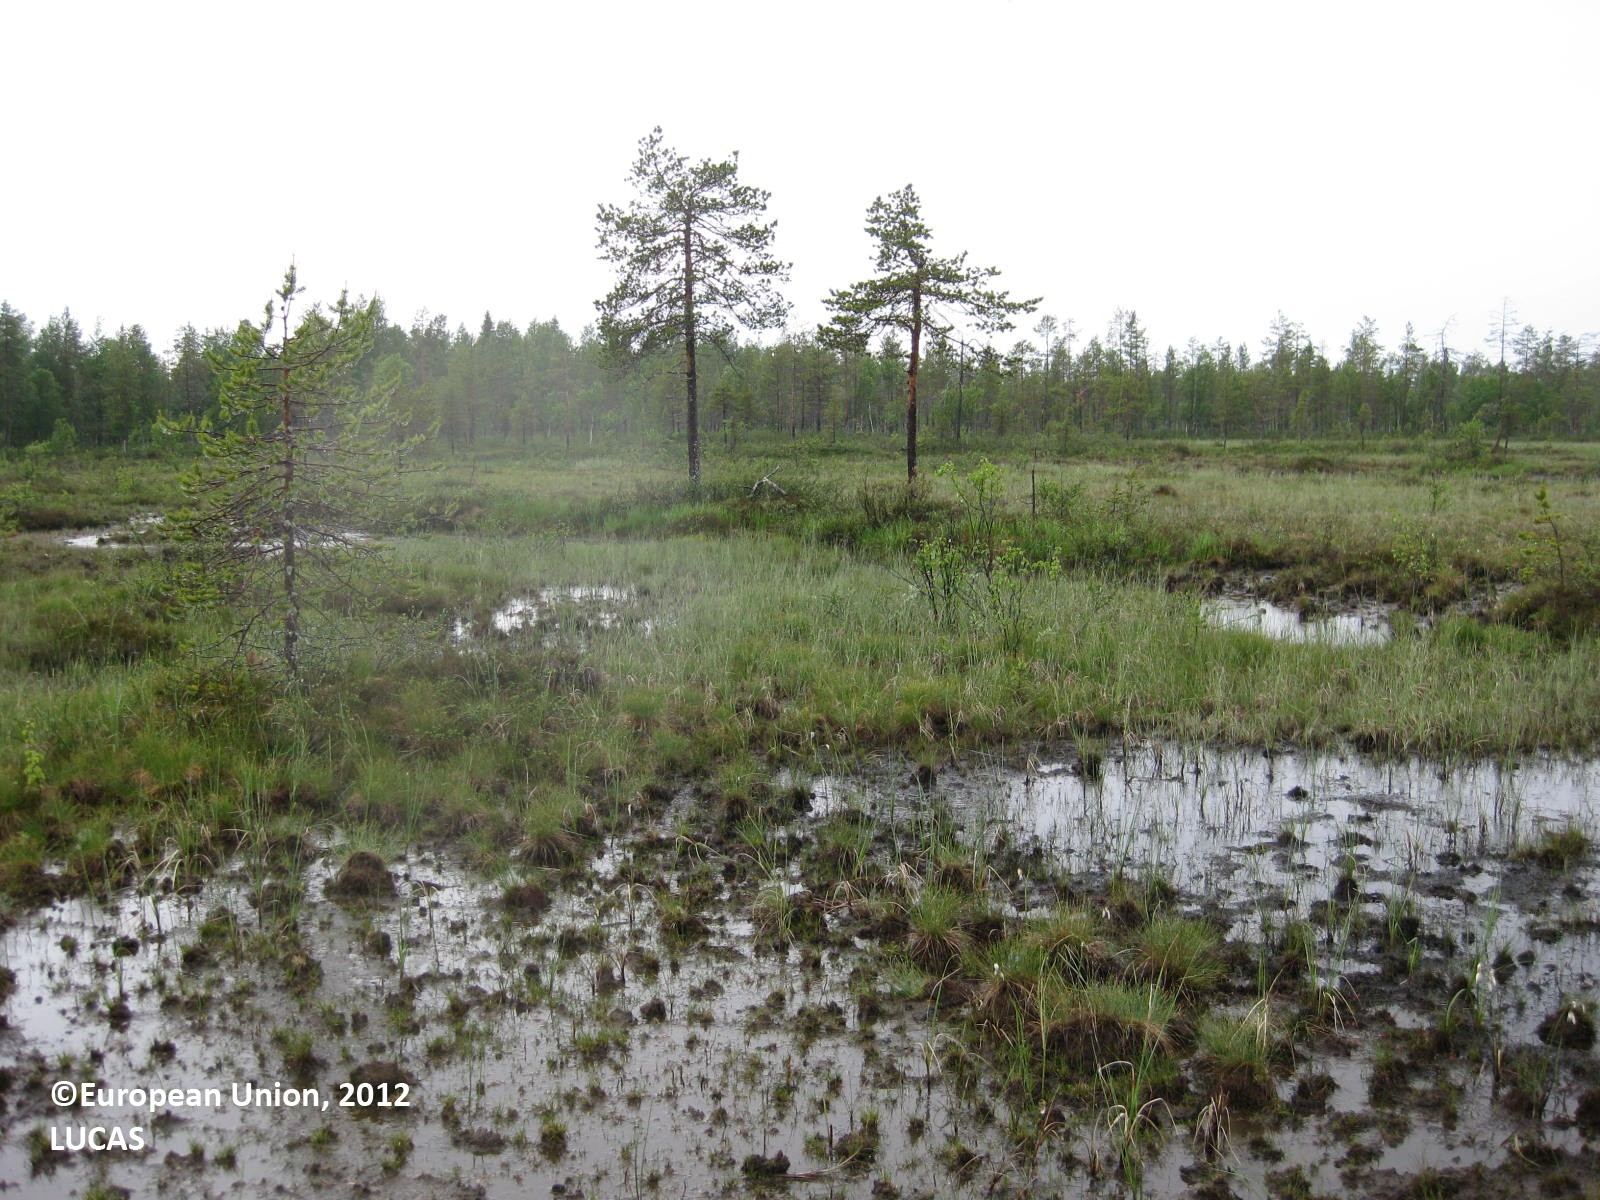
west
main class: Woodland
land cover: Pine dominated mixed woodland
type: boreal forest
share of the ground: 10 - 25 %
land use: Semi-natural and natural areas not in use
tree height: > 5 m
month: July
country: FI
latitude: 65.6702
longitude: 29.4448
